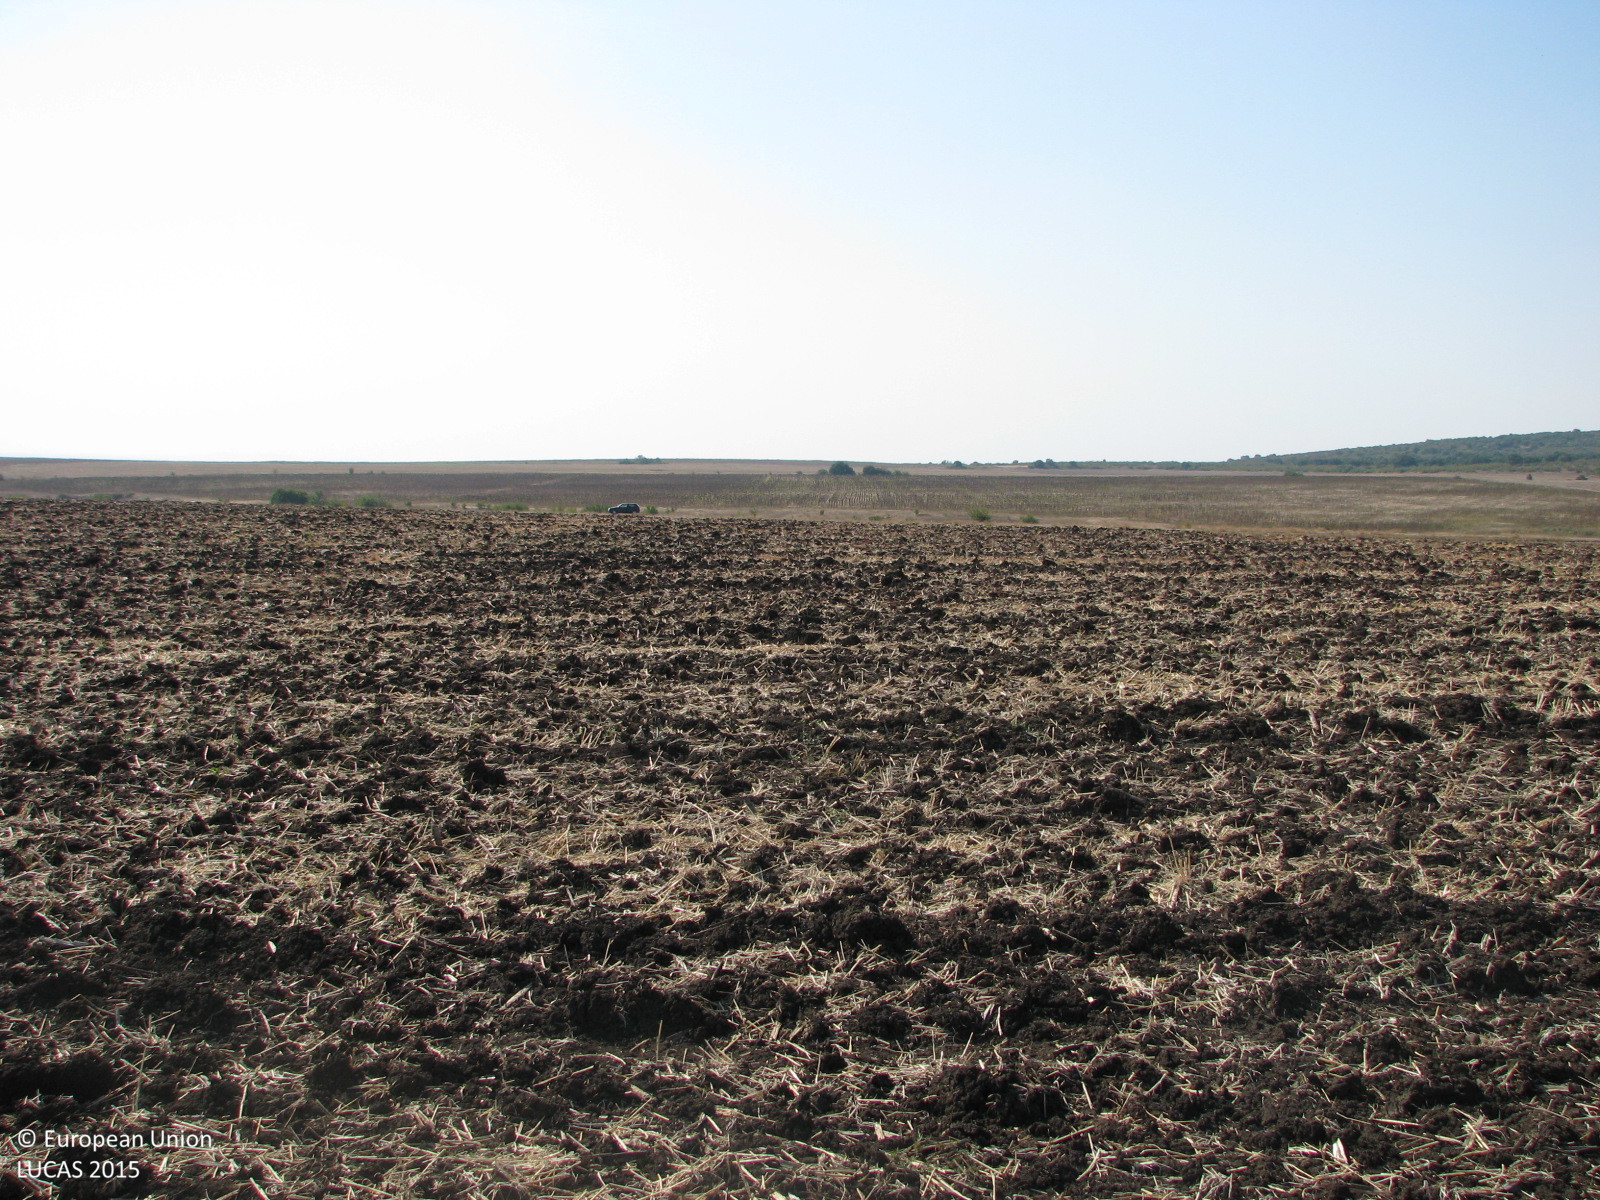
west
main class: Cropland
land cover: Common wheat
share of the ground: < 10 %
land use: Agriculture (excluding fallow land and kitchen gardens)
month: September
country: BG
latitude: 42.3885
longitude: 26.7504
